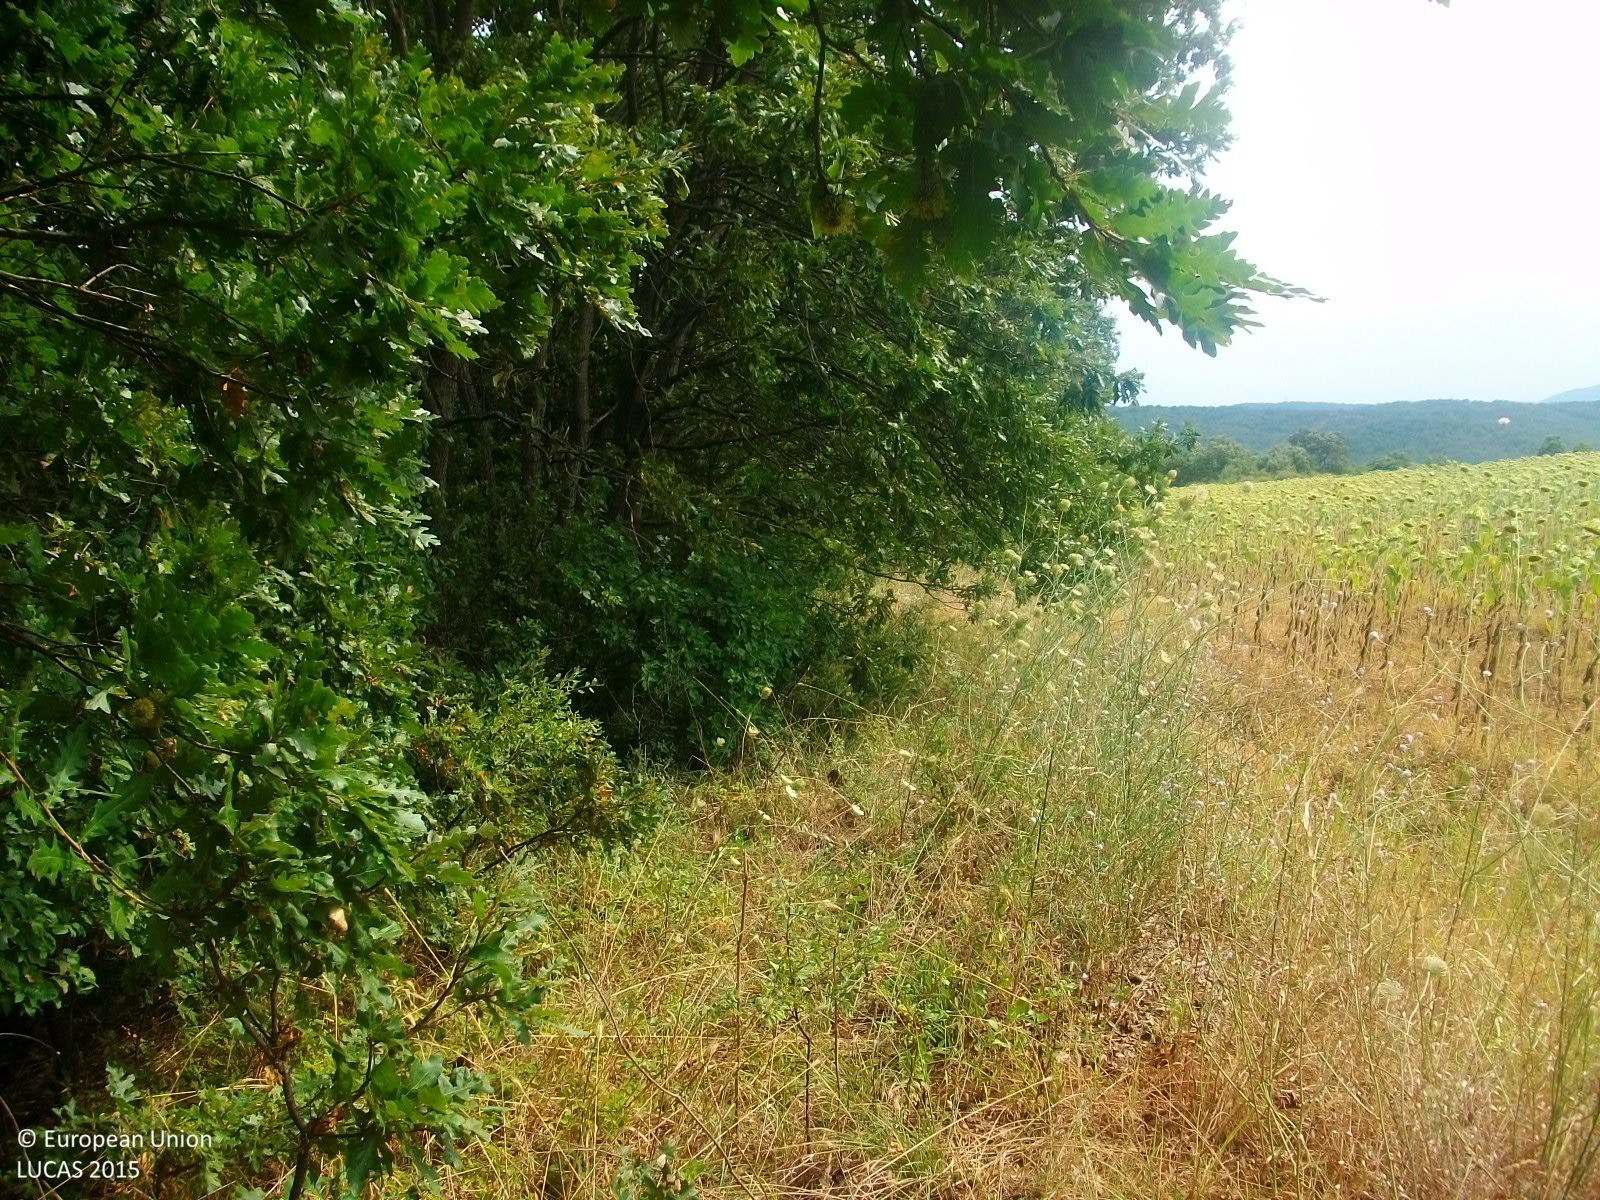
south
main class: Woodland
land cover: Broadleaved woodland
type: thermophilous deciduous forest
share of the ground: > 75 %
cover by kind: broadleaved forest trees 90 %, shrubs 10 %
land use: Semi-natural and natural areas not in use
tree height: > 5 m
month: August
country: GR
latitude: 41.3022
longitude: 26.2047
